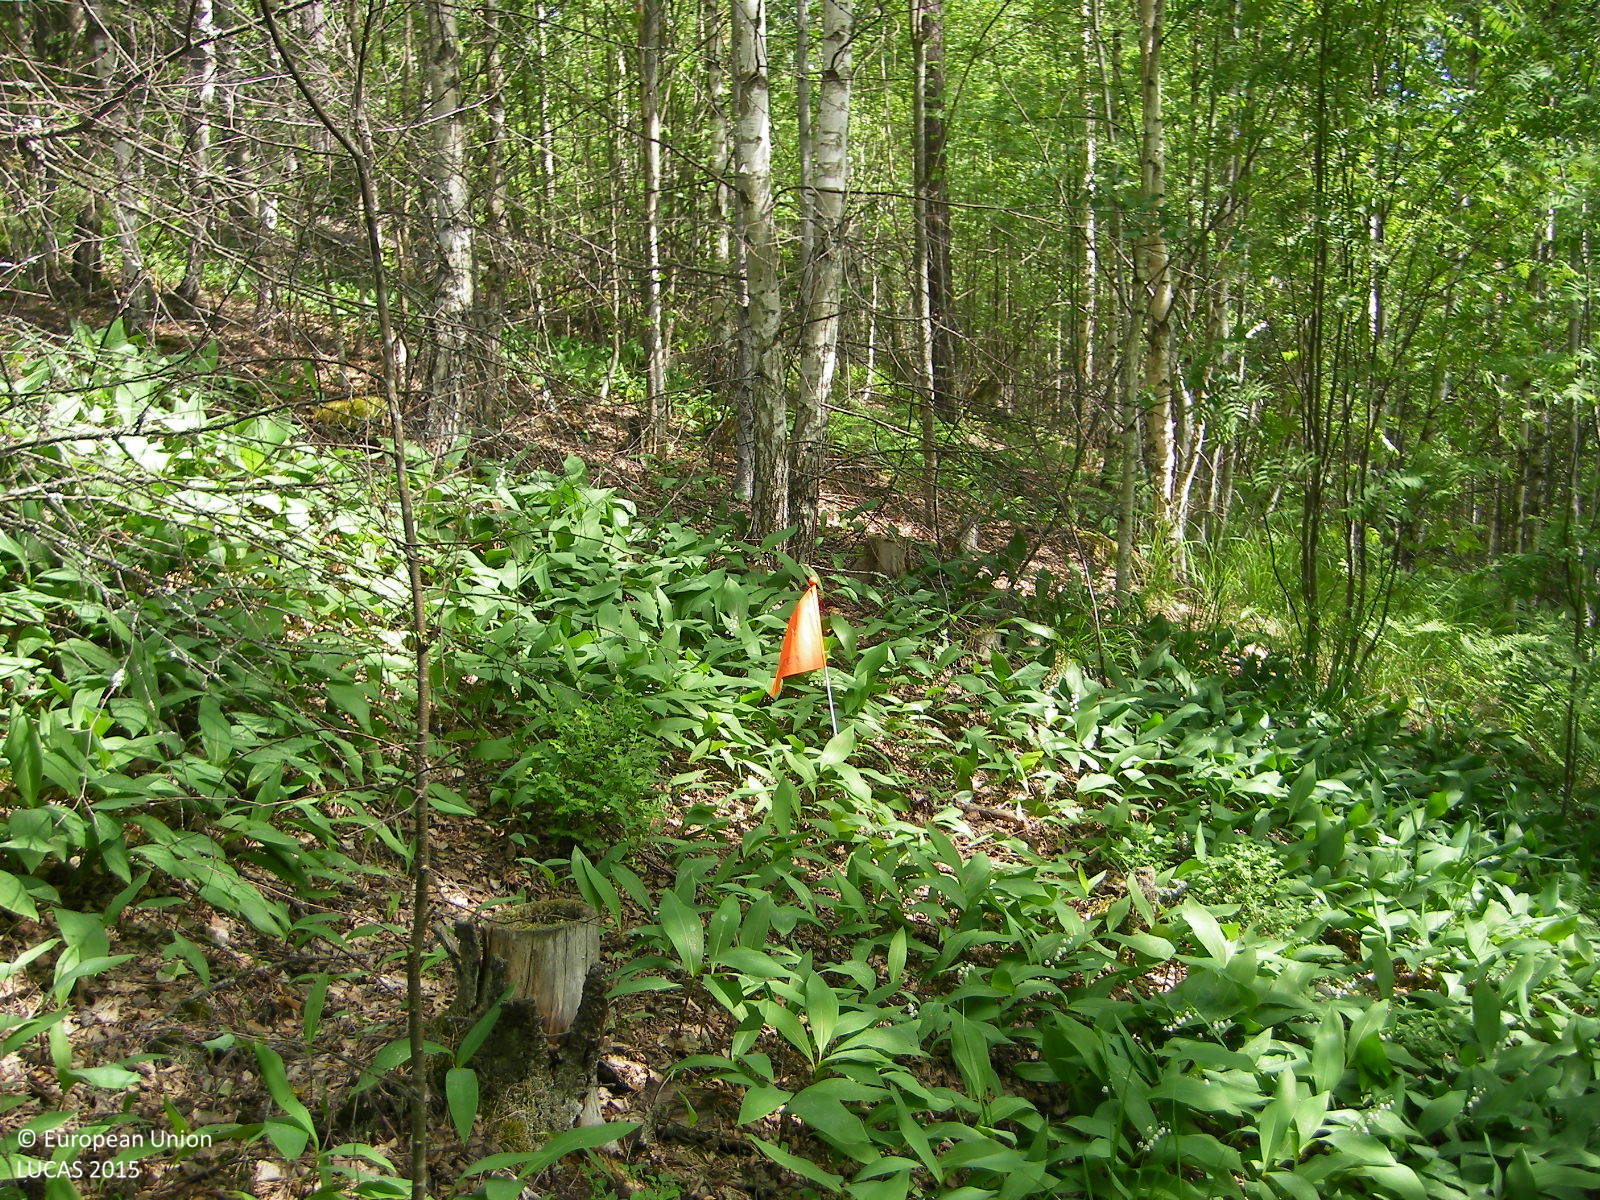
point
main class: Woodland
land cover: Broadleaved woodland
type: boreal forest
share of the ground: > 75 %
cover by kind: broadleaved forest trees 70 %, herbaceous plants 20 %, coniferous forest trees 5 %, lichens and mosses 5 %
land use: Forestry
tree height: > 5 m
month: June
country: FI
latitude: 60.4306
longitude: 24.3649
